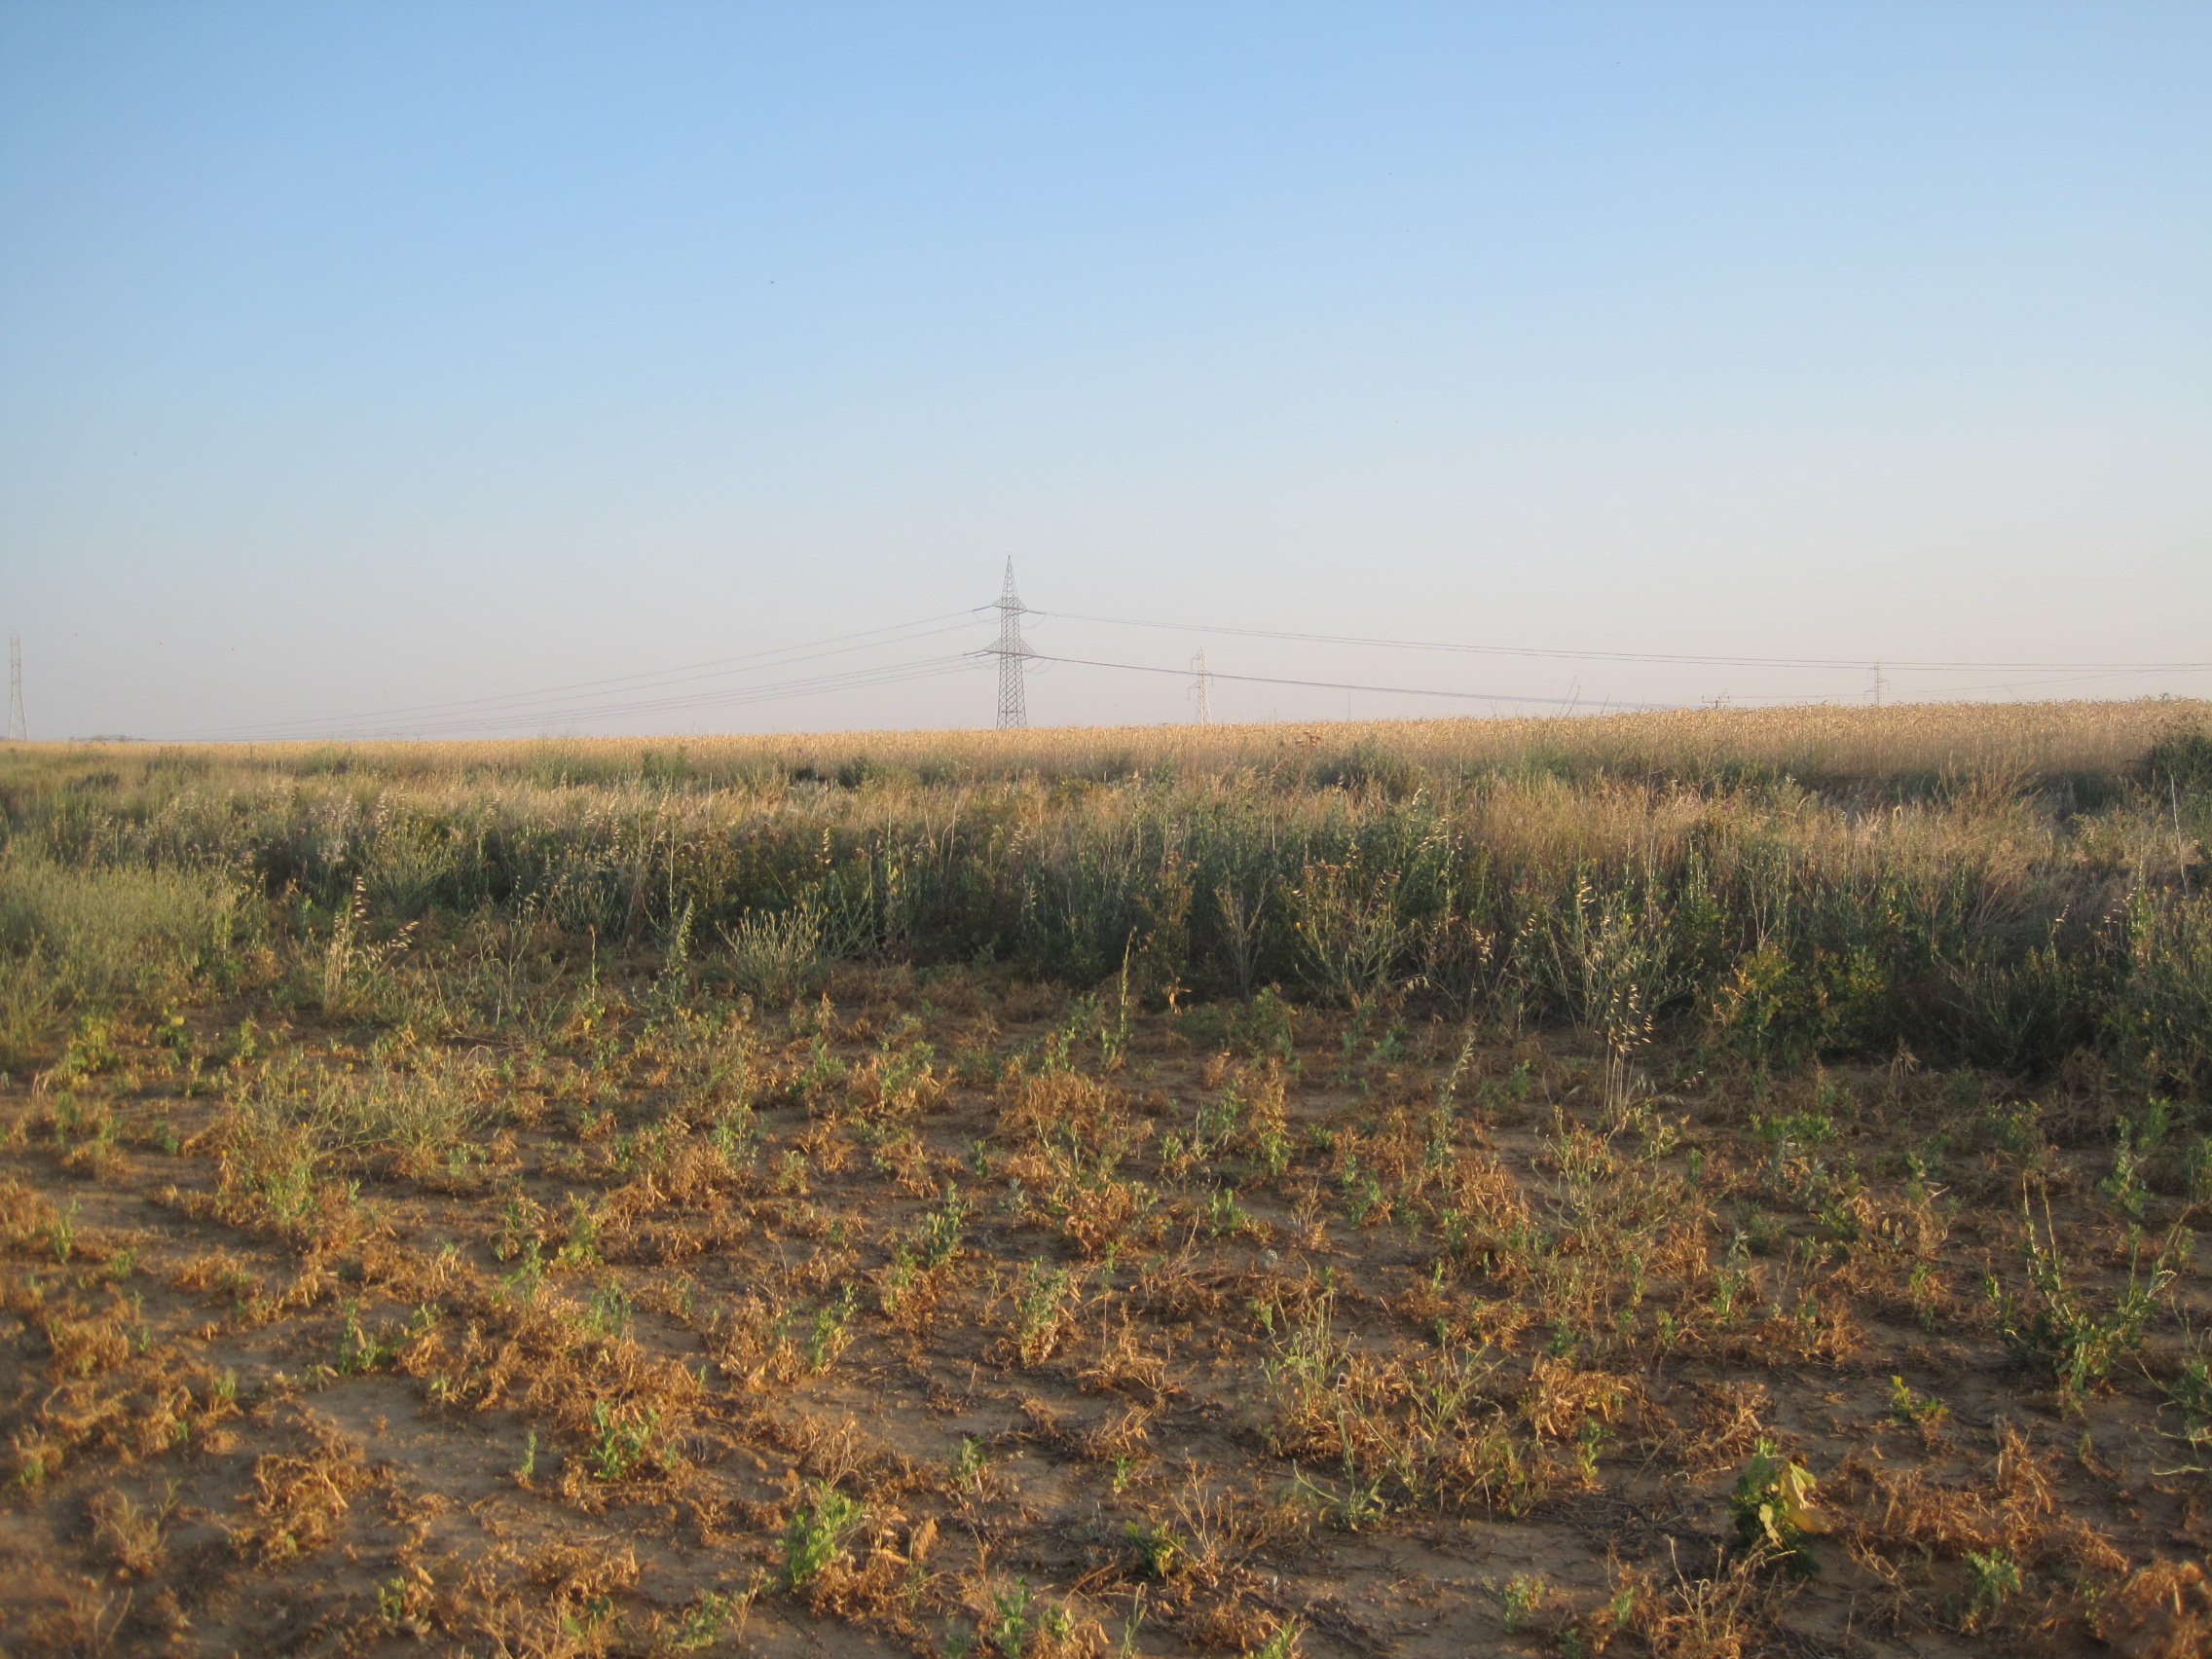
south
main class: Cropland
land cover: Dry pulses
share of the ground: 25 - 50 %
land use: Agriculture (excluding fallow land and kitchen gardens)
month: July
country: ES
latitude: 41.8909
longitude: -5.1574
